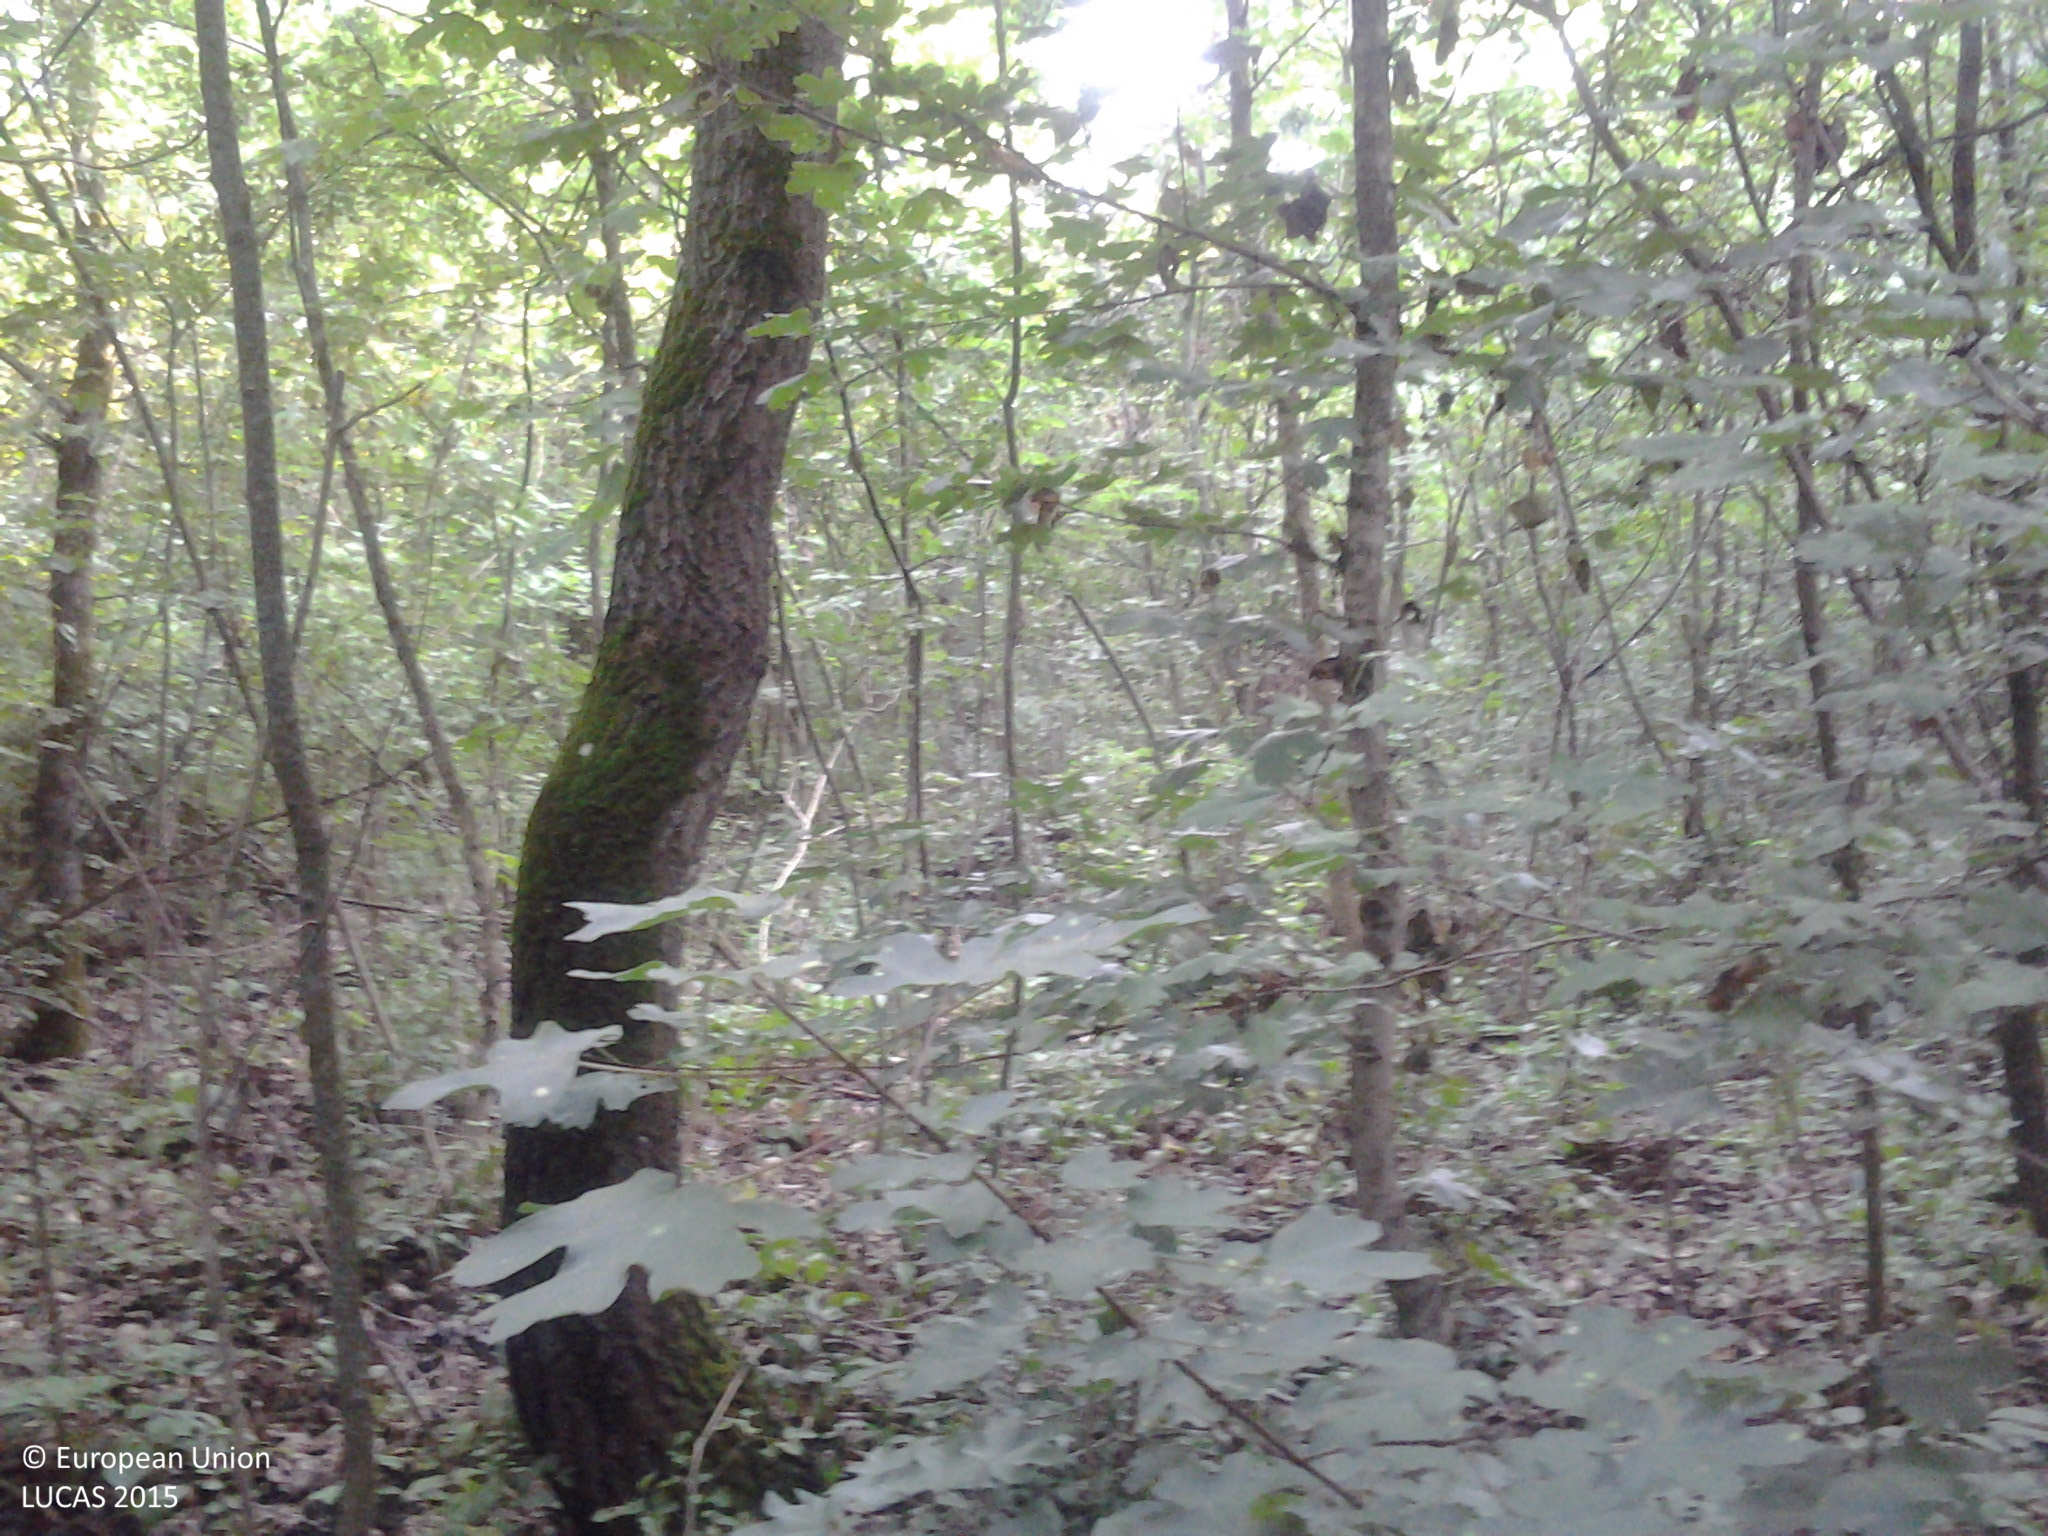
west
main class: Woodland
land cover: Broadleaved woodland
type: mesophytic deciduous forest
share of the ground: > 75 %
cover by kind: broadleaved forest trees 100 %
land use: Forestry
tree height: > 5 m
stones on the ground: 10 - 25 %
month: June
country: RO
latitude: 44.1595
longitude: 26.1465
